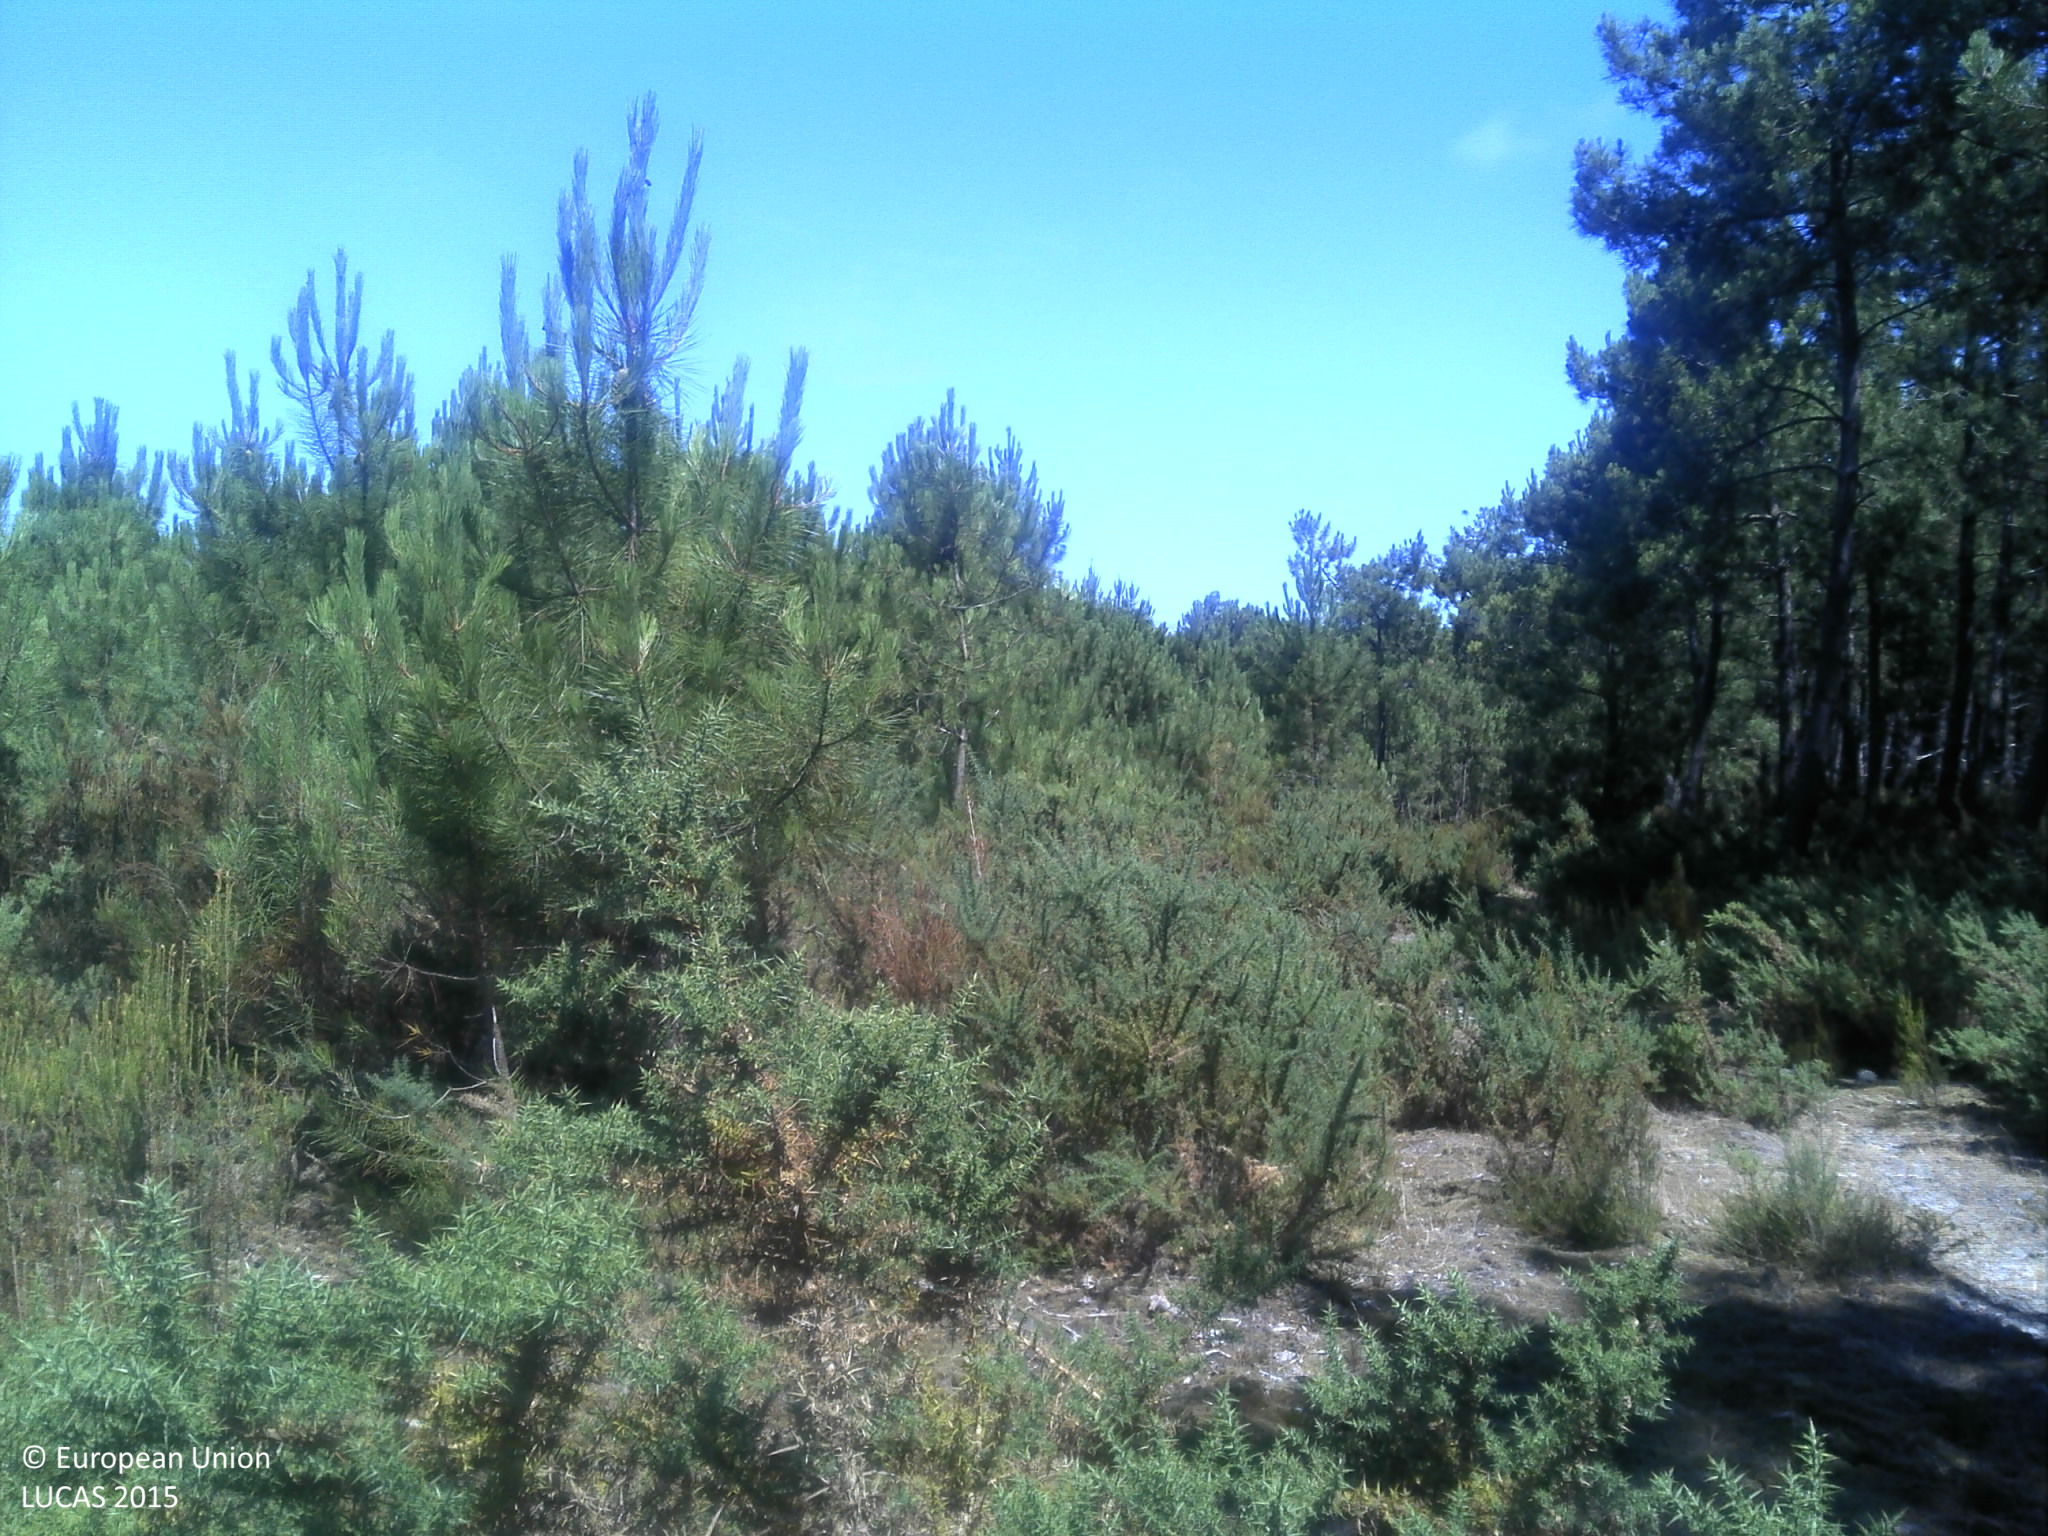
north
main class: Shrubland
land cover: Shrubland with sparse tree cover
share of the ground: > 75 %
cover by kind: shrubs 80 %, lichens and mosses 10 %, coniferous forest trees 5 %, unconsolidated bare surface 5 %
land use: Forestry
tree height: > 5 m
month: July
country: FR
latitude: 45.4227
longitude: -1.1336
